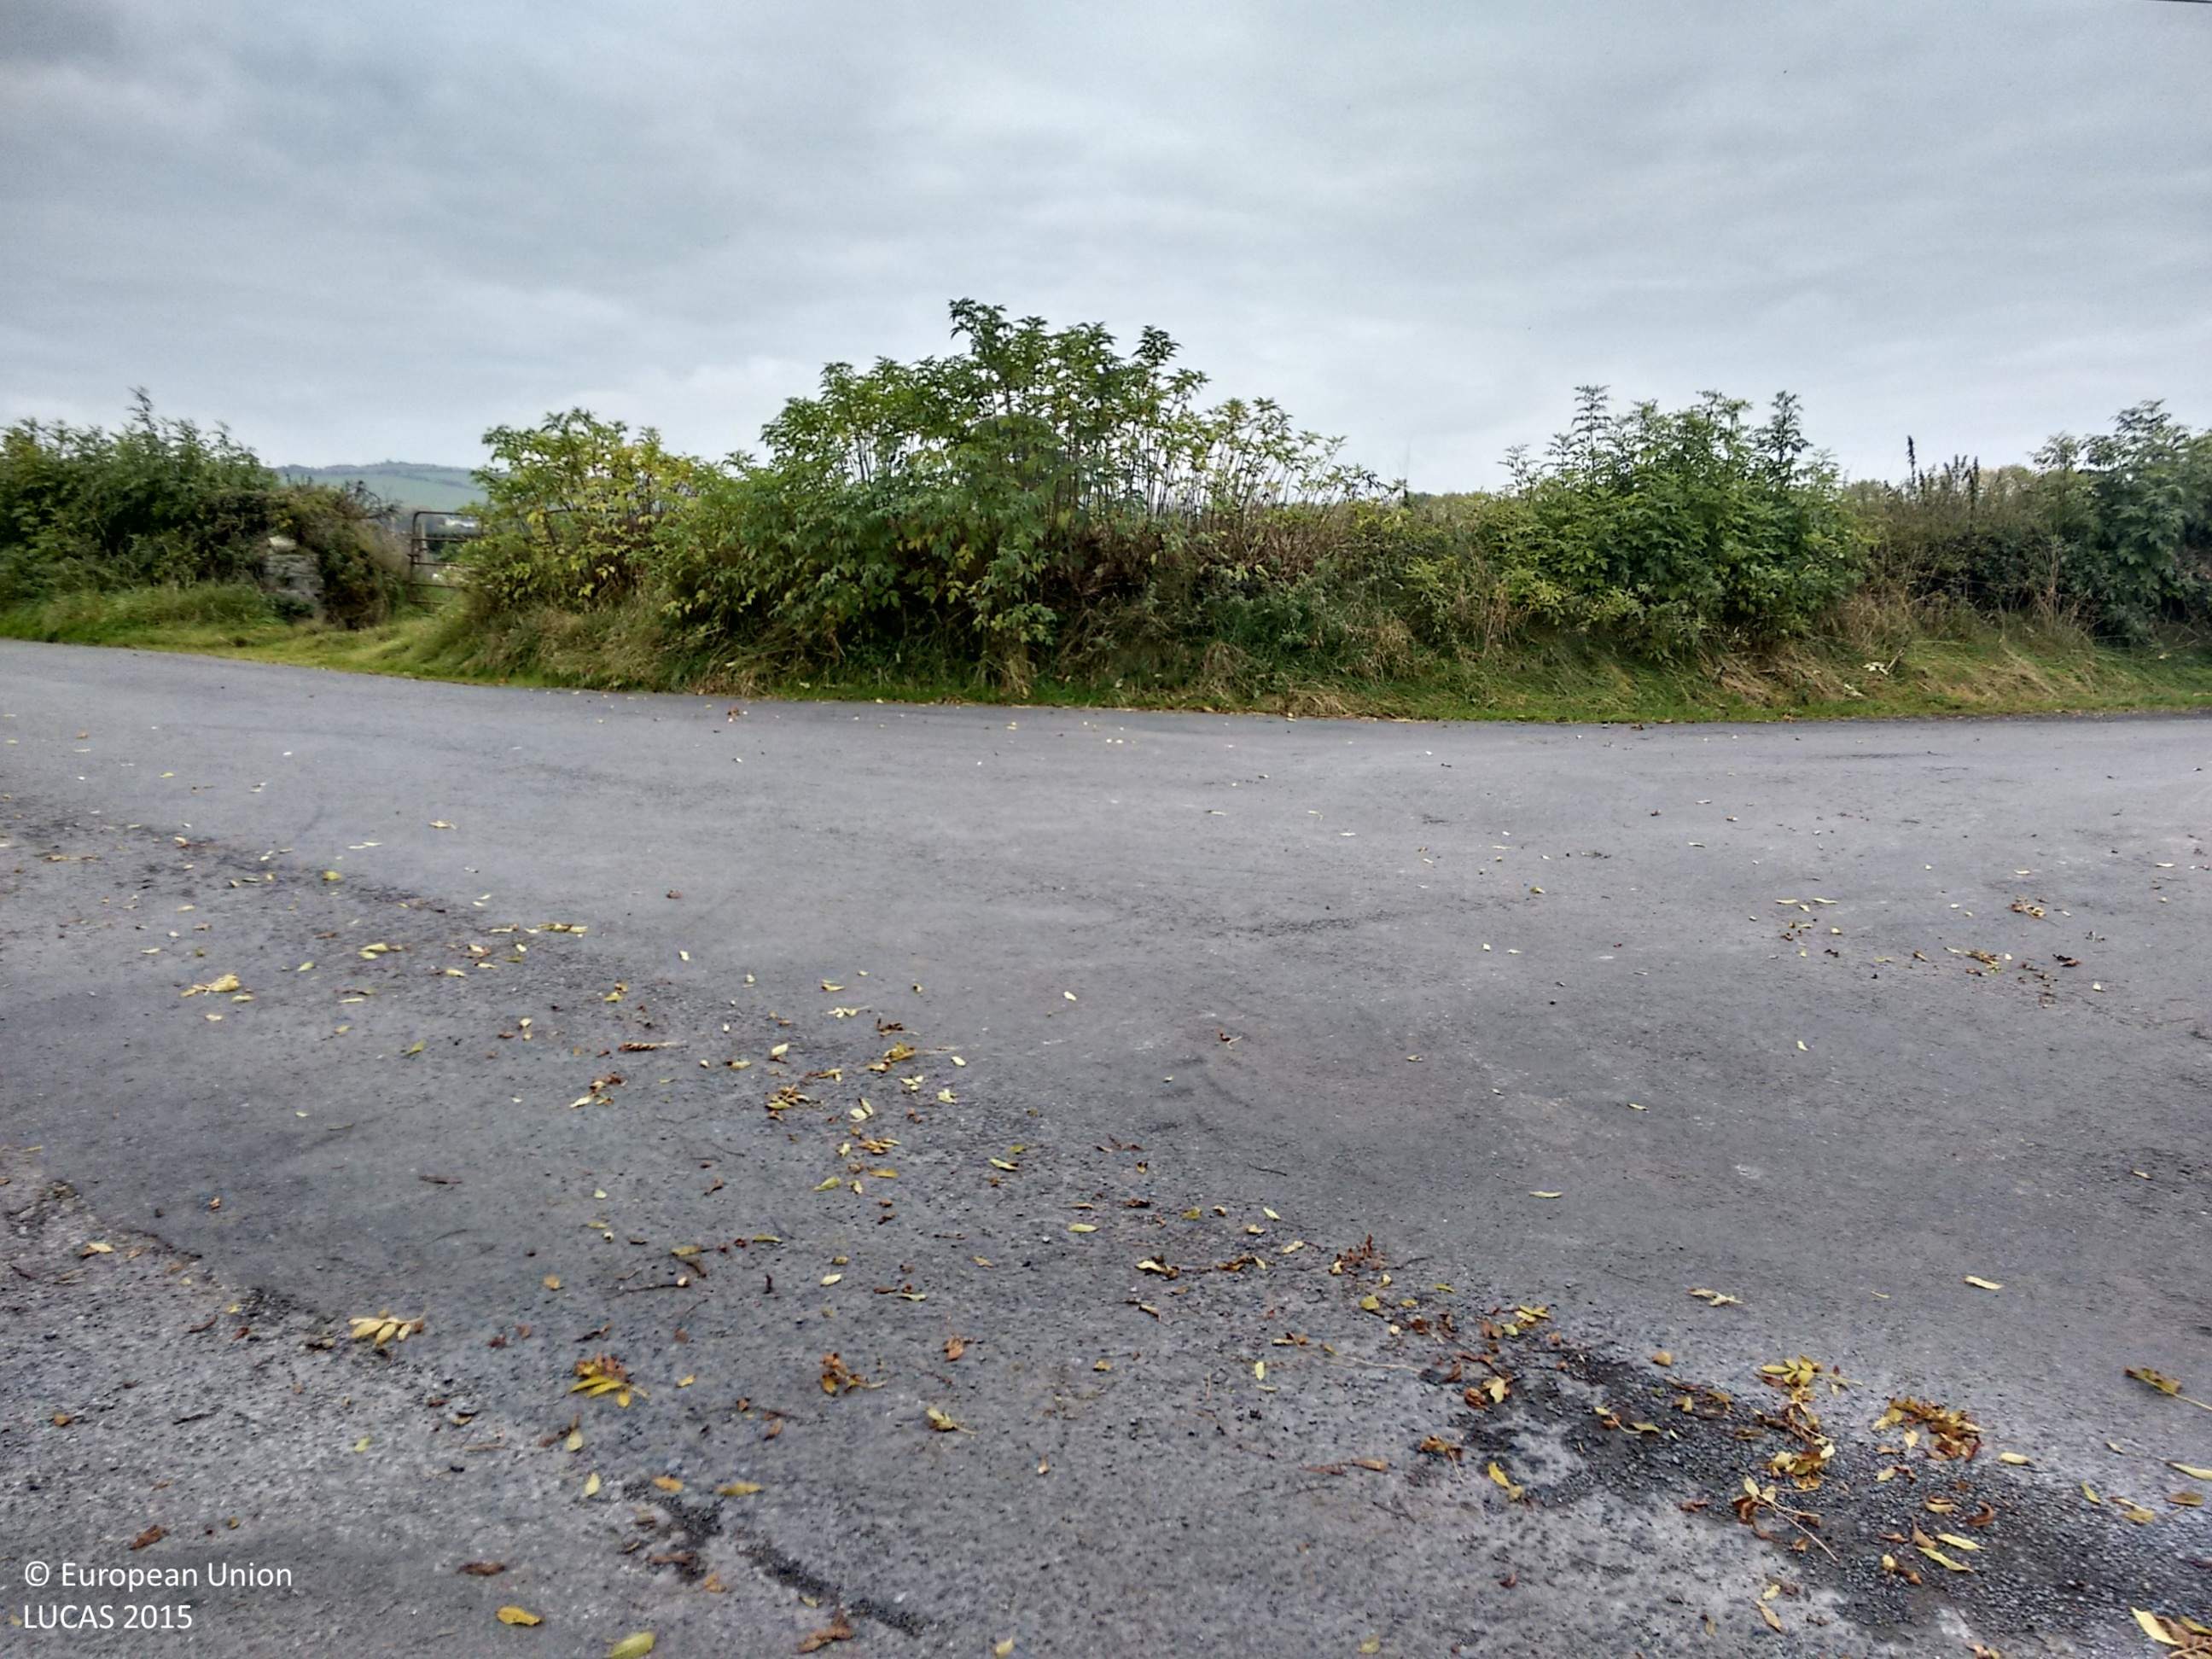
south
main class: Grassland
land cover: Grassland without tree/shrub cover
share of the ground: > 75 %
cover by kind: herbaceous plants 95 %
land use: Agriculture (excluding fallow land and kitchen gardens)
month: October
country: IE
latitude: 52.8125
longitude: -7.5025
